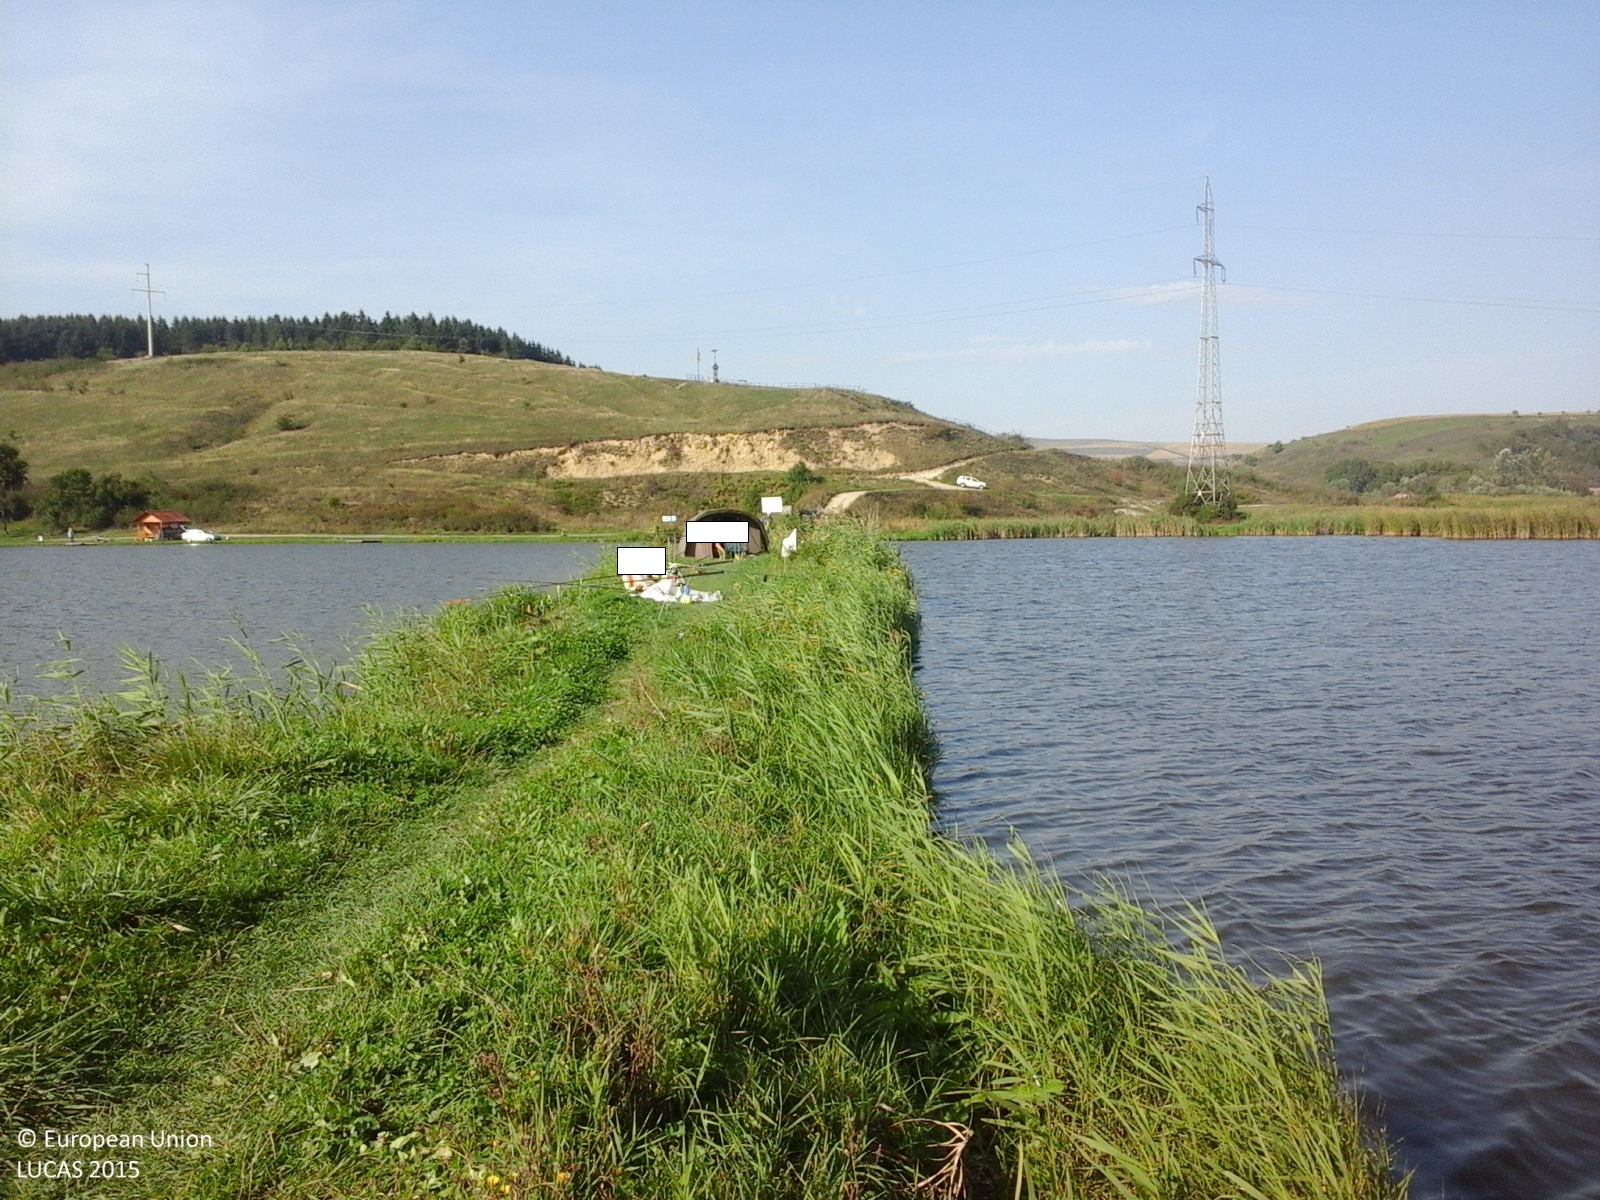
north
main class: Grassland
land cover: Grassland without tree/shrub cover
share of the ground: > 75 %
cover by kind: herbaceous plants 100 %
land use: Amenities, museums, leisure
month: September
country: RO
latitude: 46.6546
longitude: 23.6749
